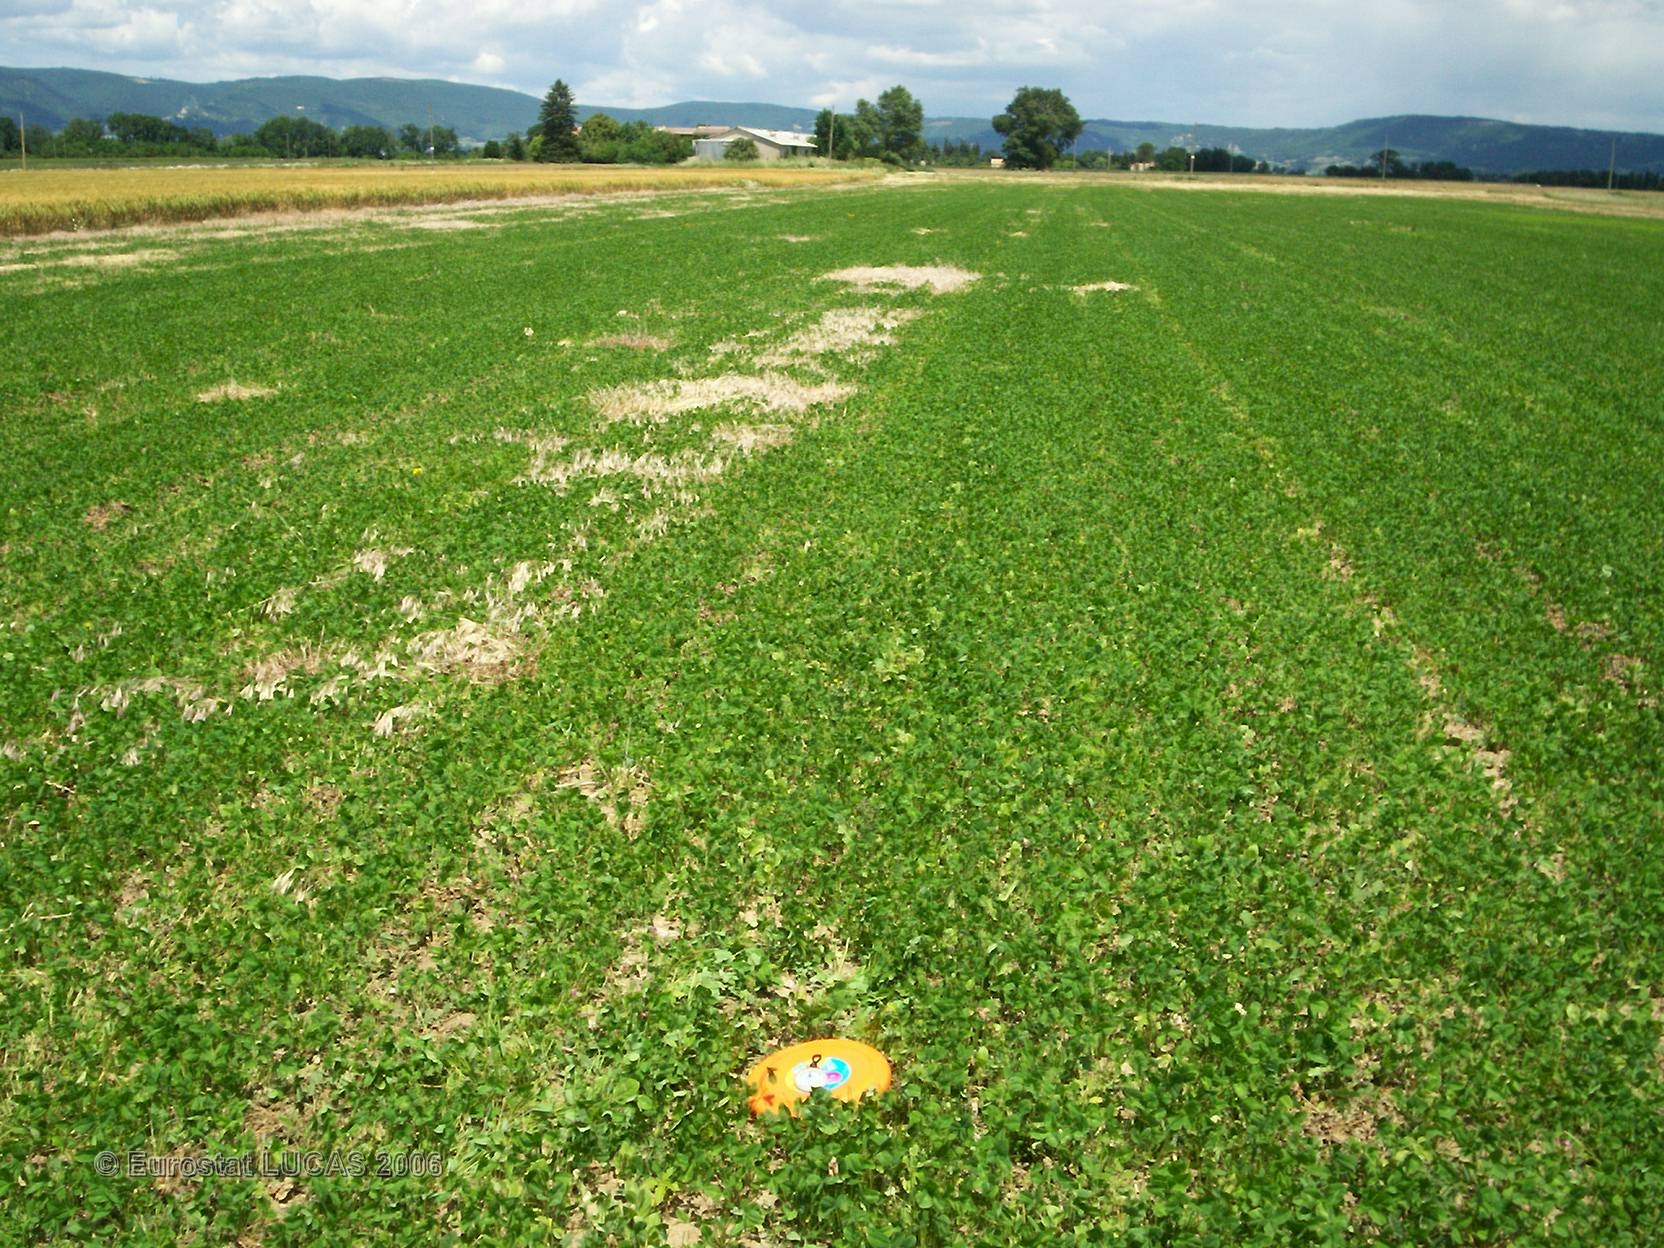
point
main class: Cropland
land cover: Clovers
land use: Agriculture (excluding fallow land and kitchen gardens)
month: May
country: FR
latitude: 44.5868
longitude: 4.9054
